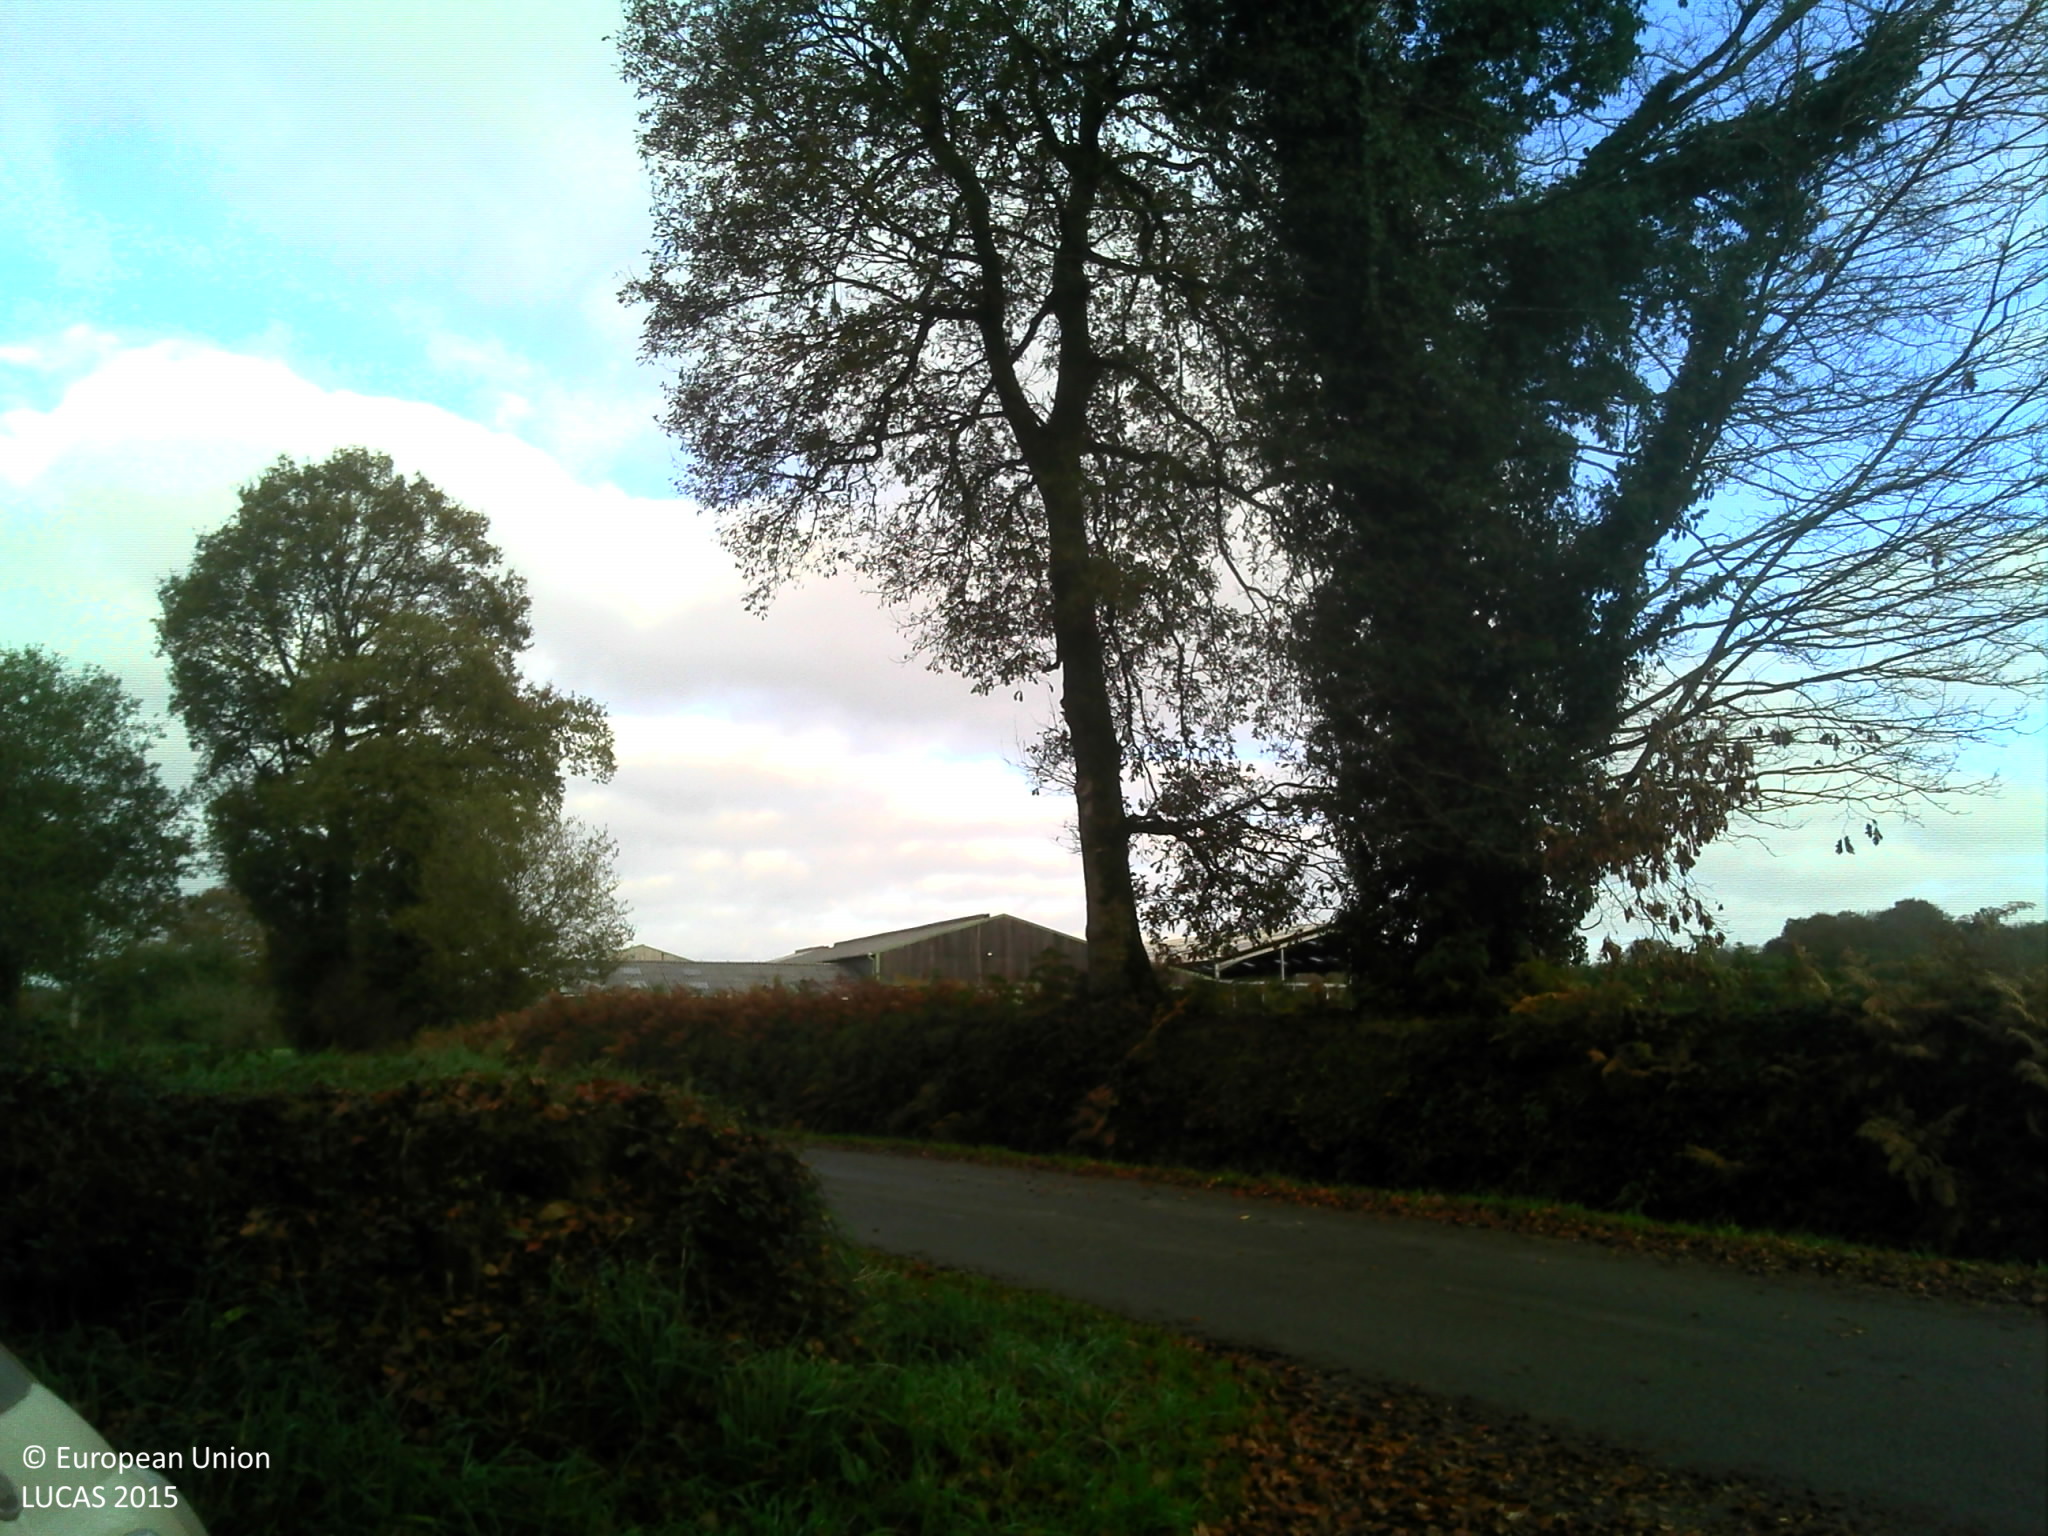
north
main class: Woodland
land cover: Broadleaved woodland
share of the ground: > 75 %
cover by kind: broadleaved forest trees 100 %
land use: Agriculture (excluding fallow land and kitchen gardens)
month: November
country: FR
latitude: 48.0658
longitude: -3.1822
